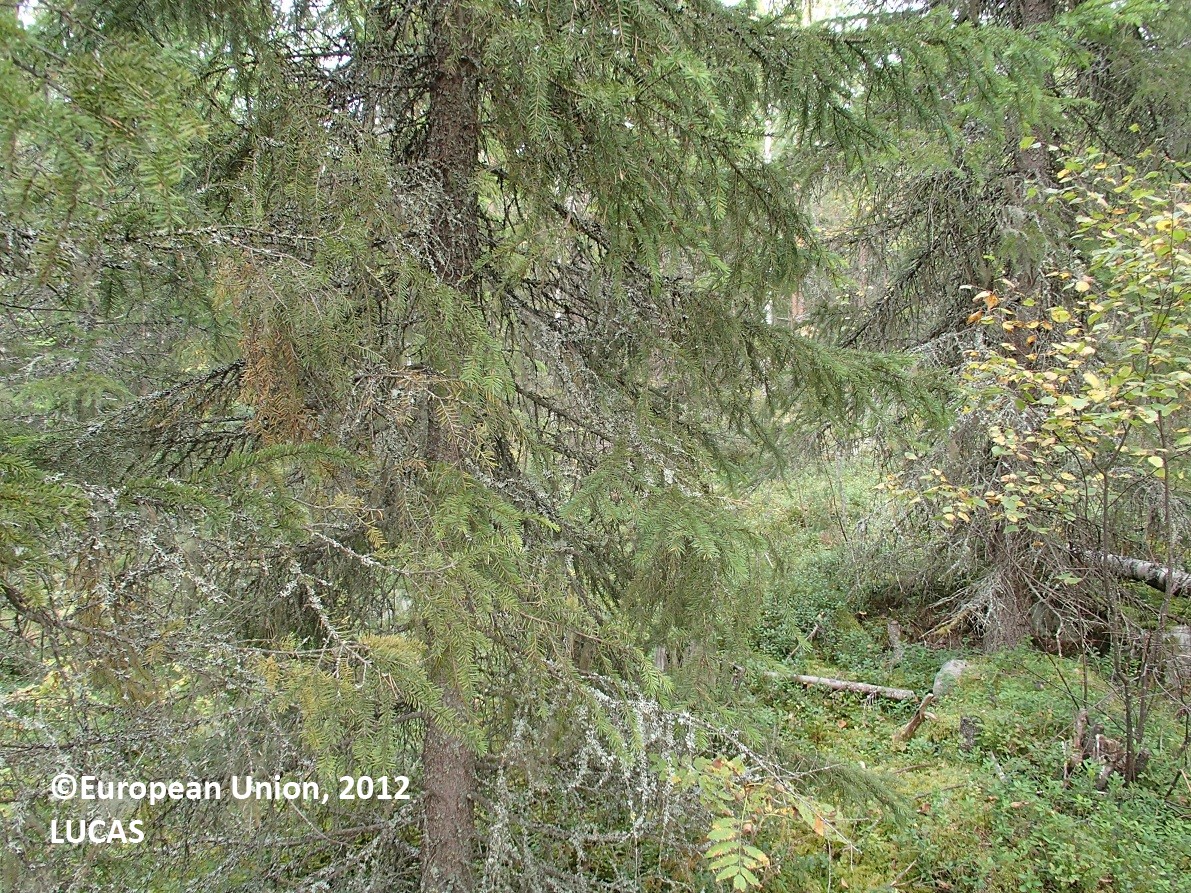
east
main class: Woodland
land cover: Other coniferous woodland
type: boreal forest
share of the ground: 50 - 75 %
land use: Forestry
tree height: > 5 m
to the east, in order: Other coniferous woodland
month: August
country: FI
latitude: 63.7463
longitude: 26.6832
